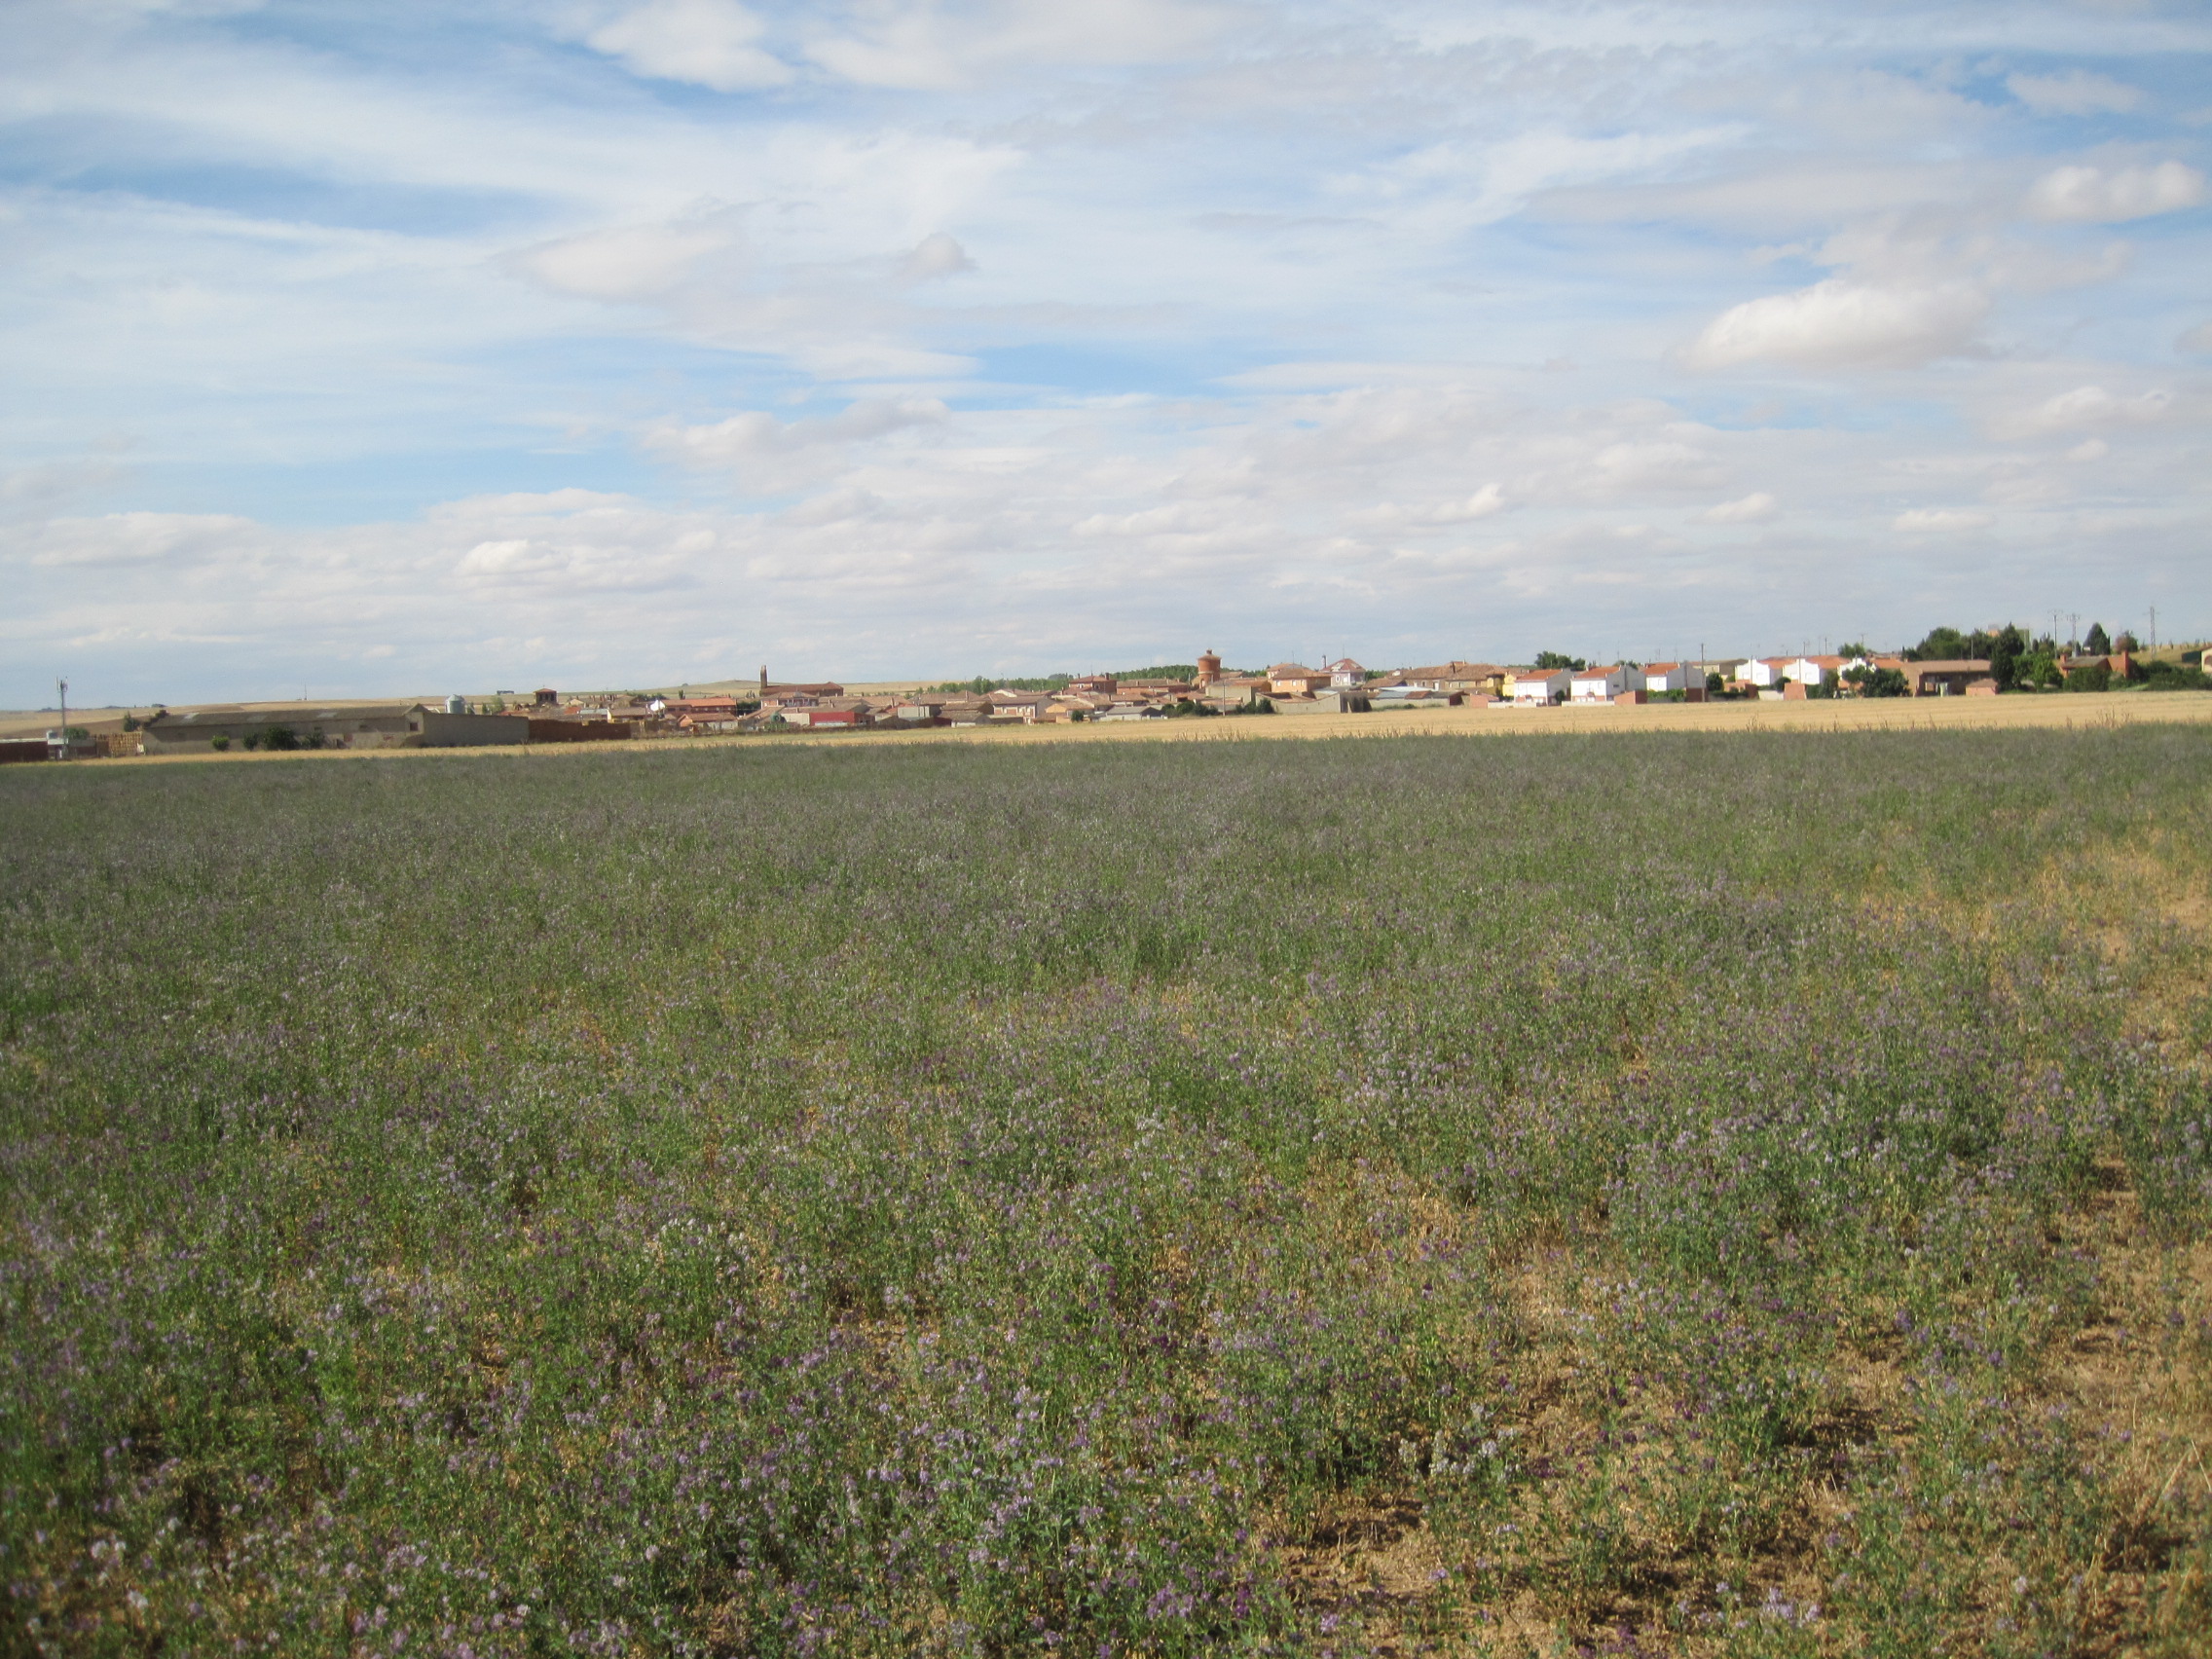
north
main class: Cropland
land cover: Lucerne
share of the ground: > 75 %
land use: Agriculture (excluding fallow land and kitchen gardens)
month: July
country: ES
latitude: 42.0000
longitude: -5.2835
